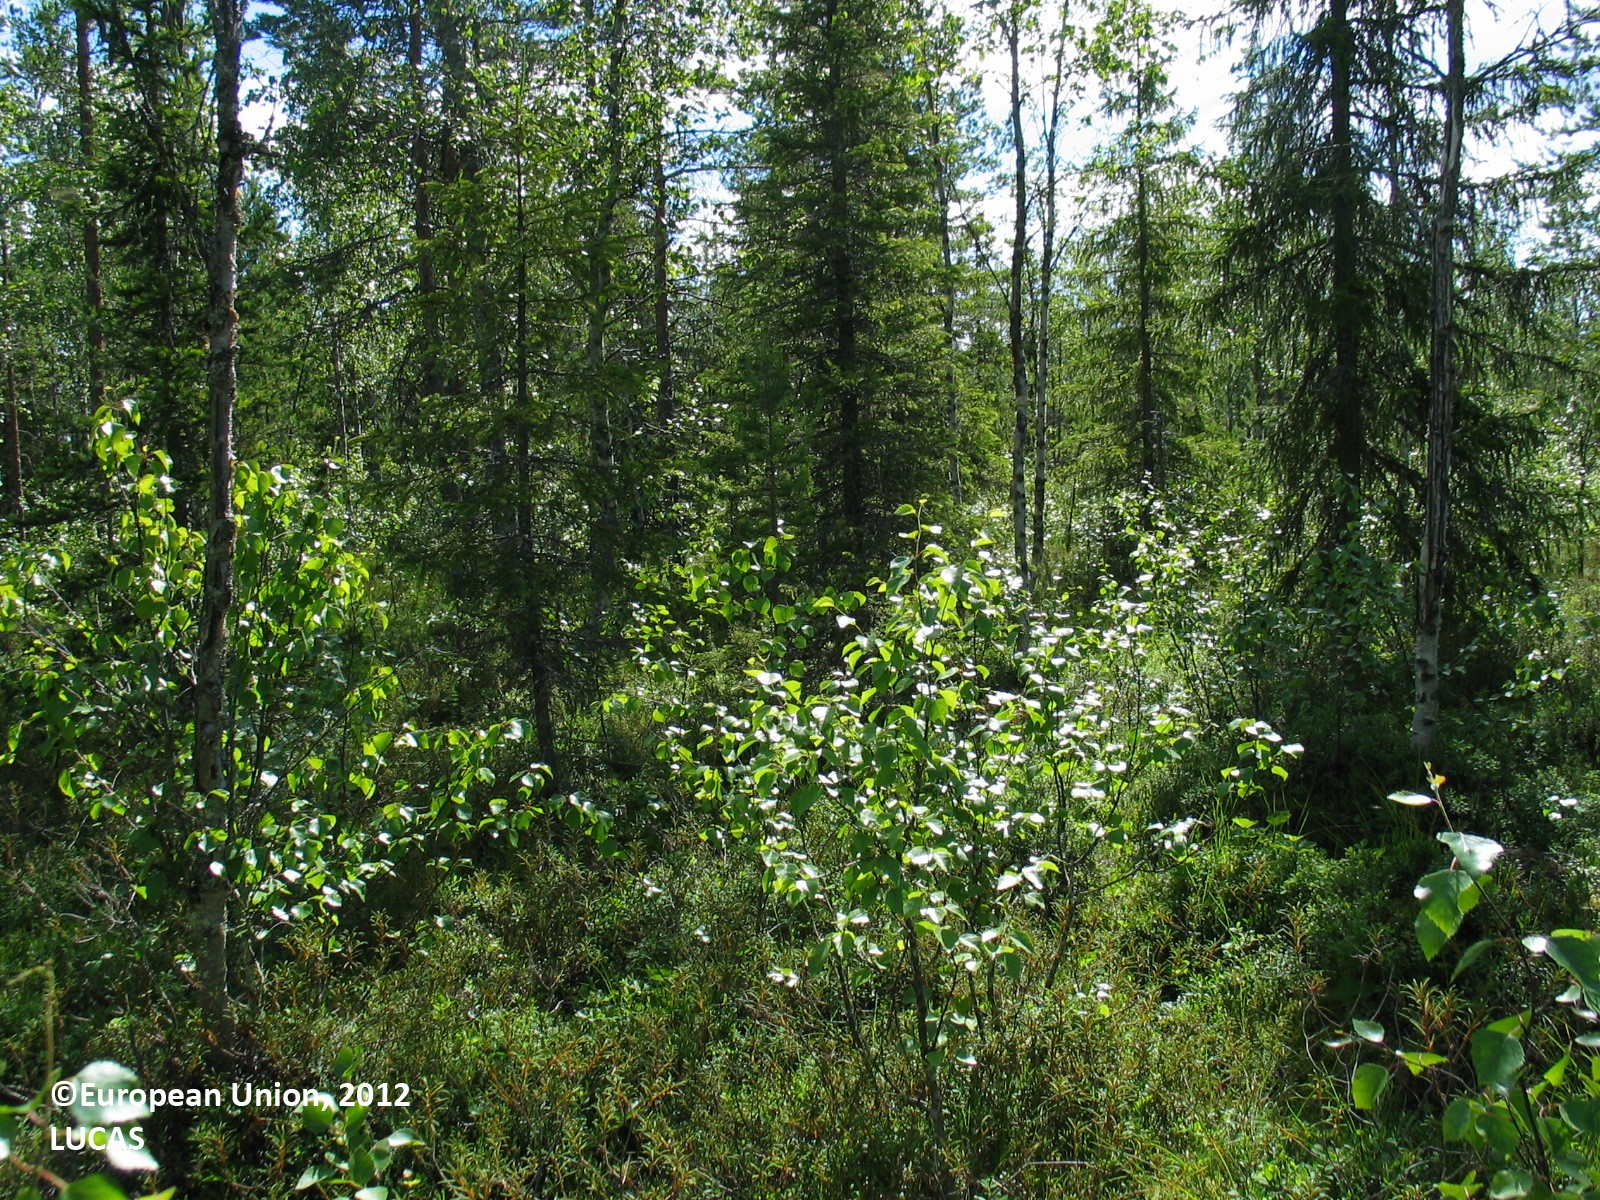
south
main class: Woodland
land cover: Other mixed woodland
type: mire and swamp forests
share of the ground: 25 - 50 %
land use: Forestry
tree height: > 5 m
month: July
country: FI
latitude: 65.9565
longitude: 24.9513
